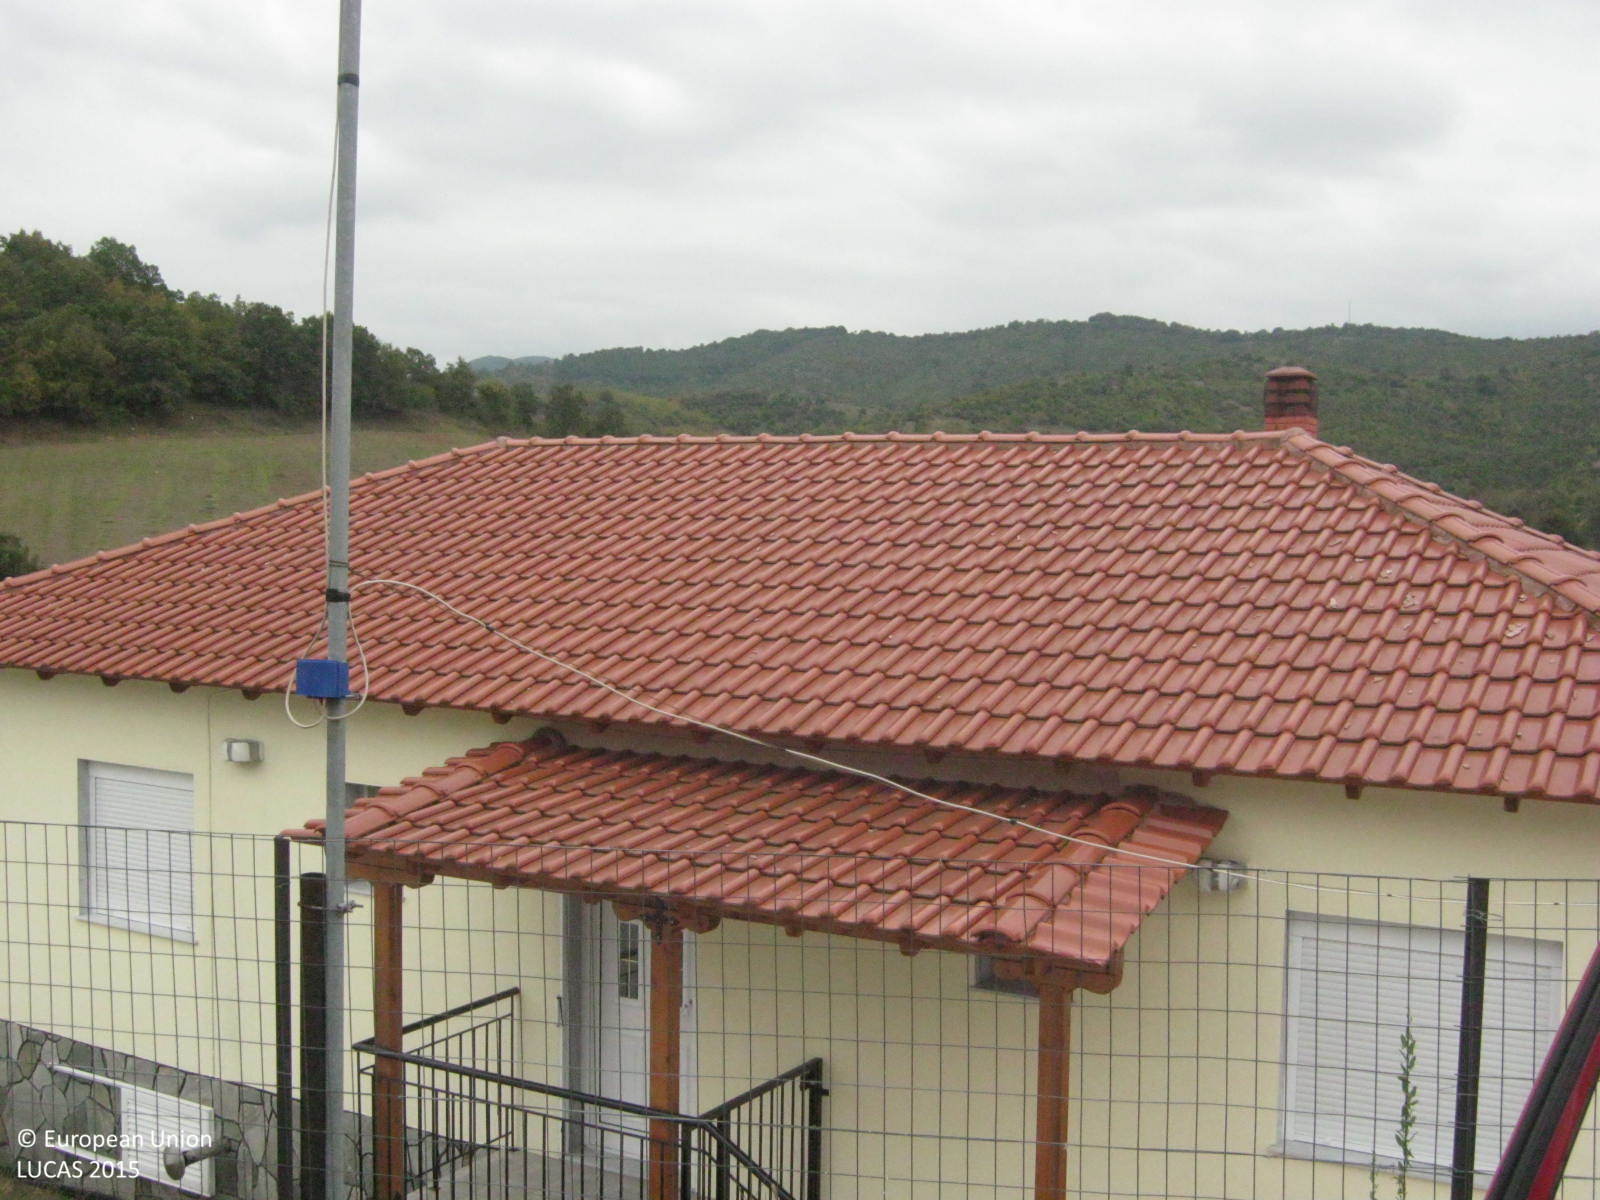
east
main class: Woodland
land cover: Broadleaved woodland
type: thermophilous deciduous forest
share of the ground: > 75 %
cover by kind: broadleaved forest trees 75 %, herbaceous plants 10 %, unconsolidated bare surface 10 %, shrubs 5 %
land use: Semi-natural and natural areas not in use
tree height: > 5 m
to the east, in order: Broadleaved woodland; Inland fresh running water; Broadleaved woodland; Spontaneously vegetated surfaces; Fences; Broadleaved woodland; Rivers and streams; Broadleaved woodland
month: October
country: GR
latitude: 41.0720
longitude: 23.0696
